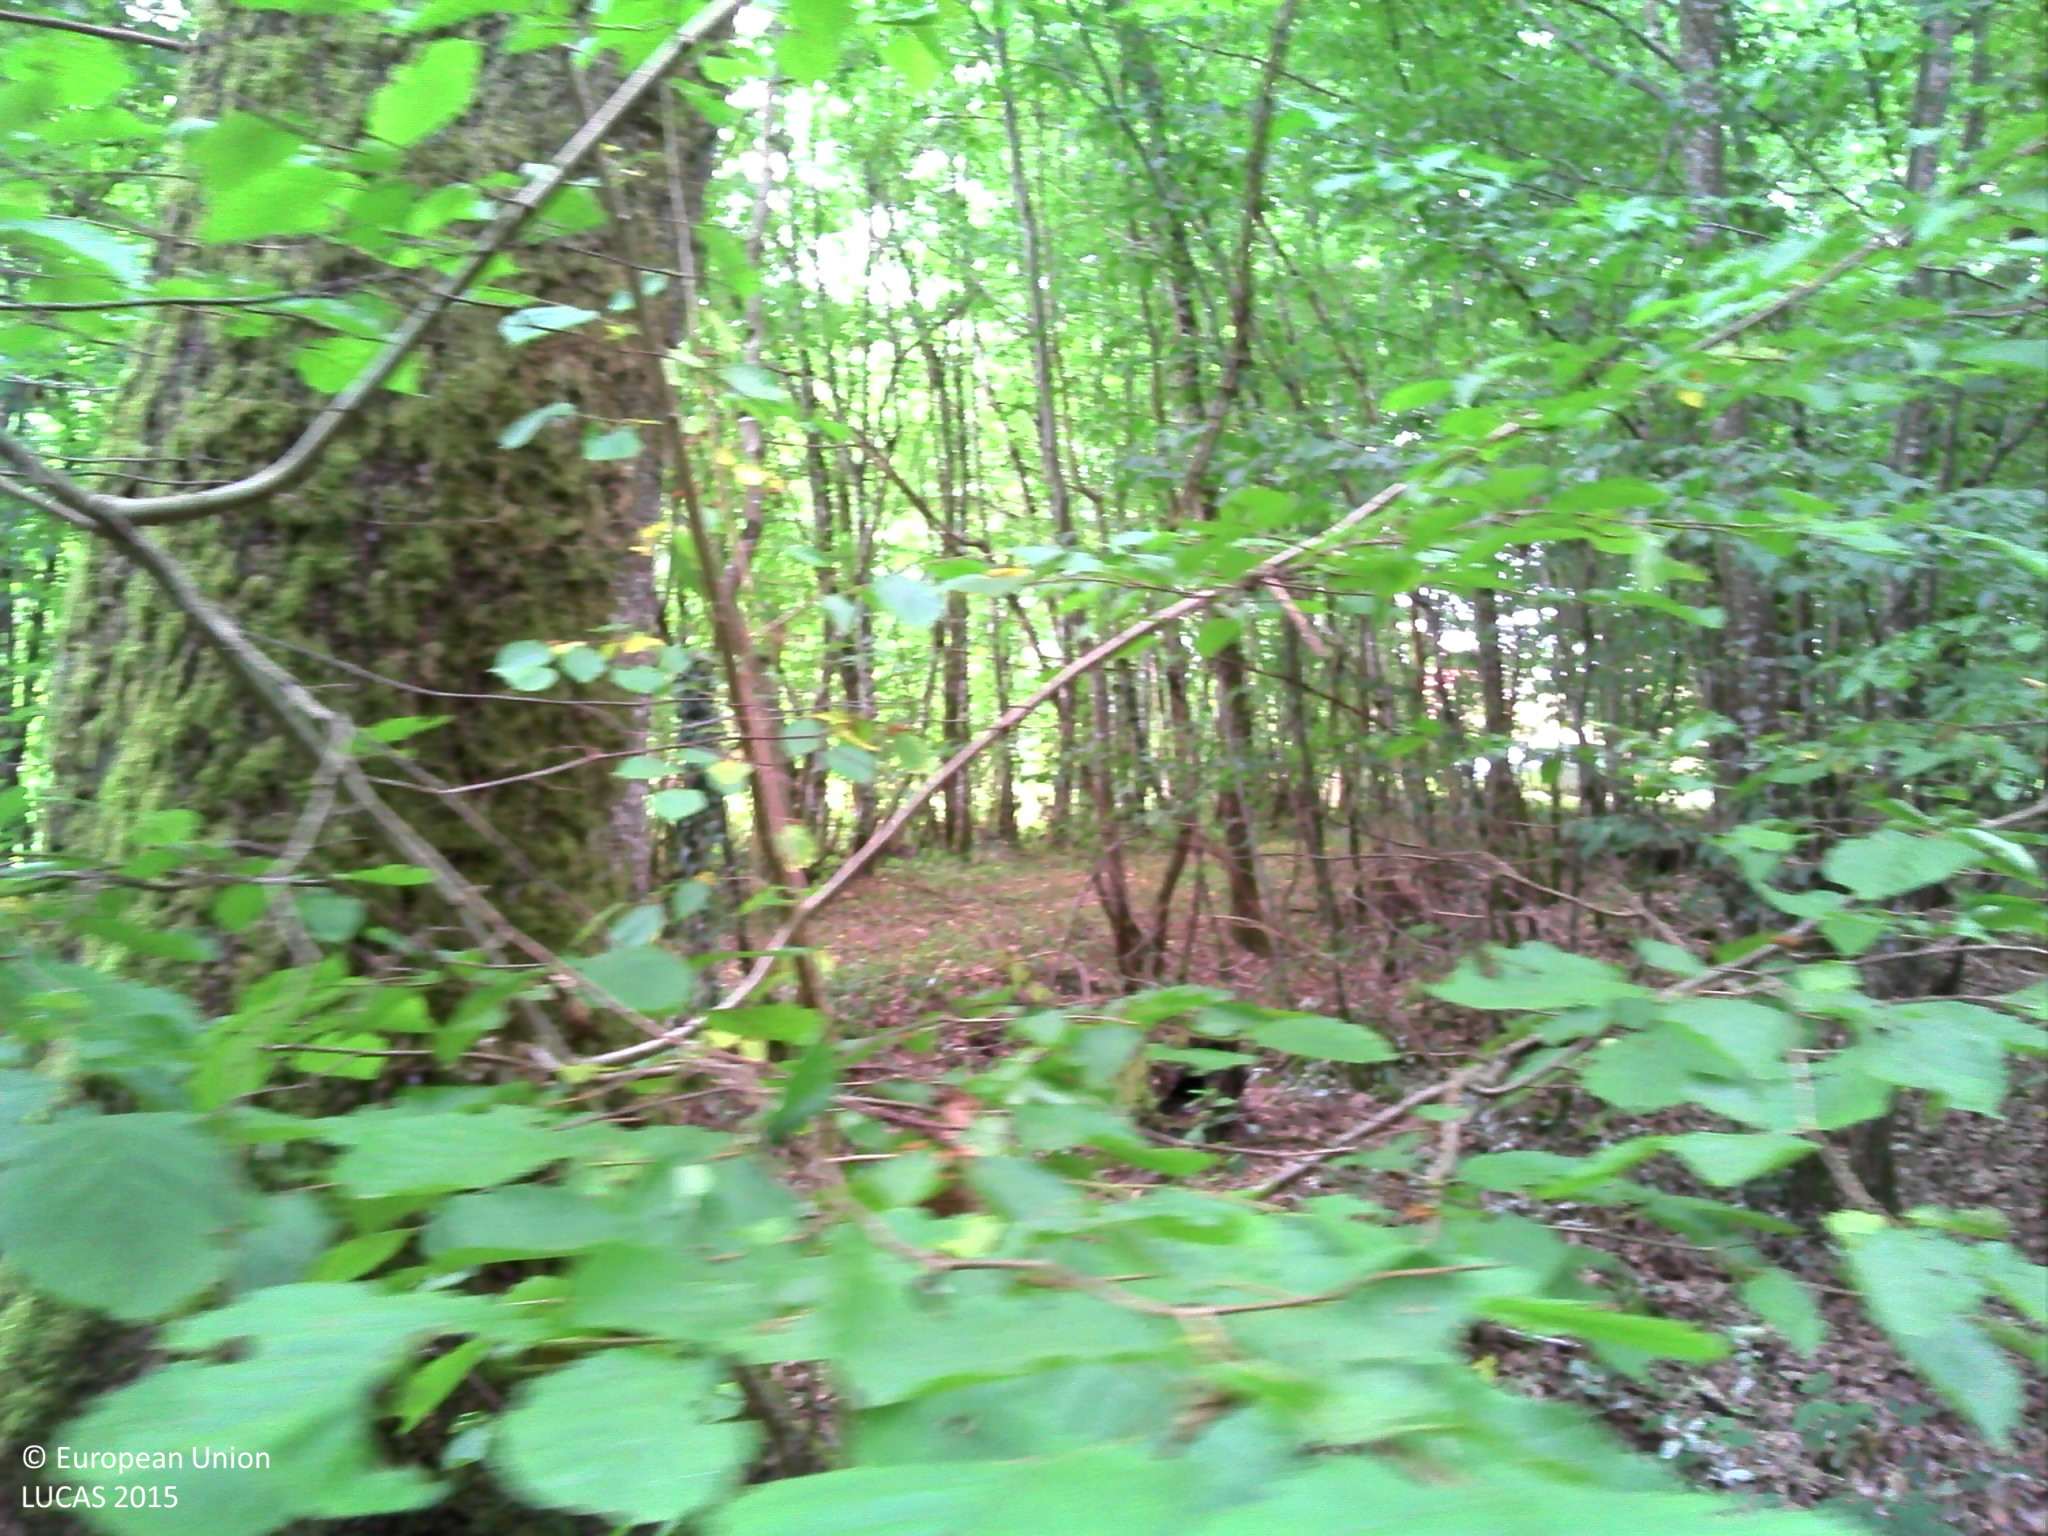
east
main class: Woodland
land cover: Broadleaved woodland
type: mesophytic deciduous forest
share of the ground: > 75 %
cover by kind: broadleaved forest trees 100 %
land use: Forestry
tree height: > 5 m
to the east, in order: Broadleaved woodland; Ditches and canals; Grassland without tree/shrub cover; Ditches and canals; Tracks; Broadleaved woodland; Grassland without tree/shrub cover
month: July
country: FR
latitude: 46.7363
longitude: 3.2838
